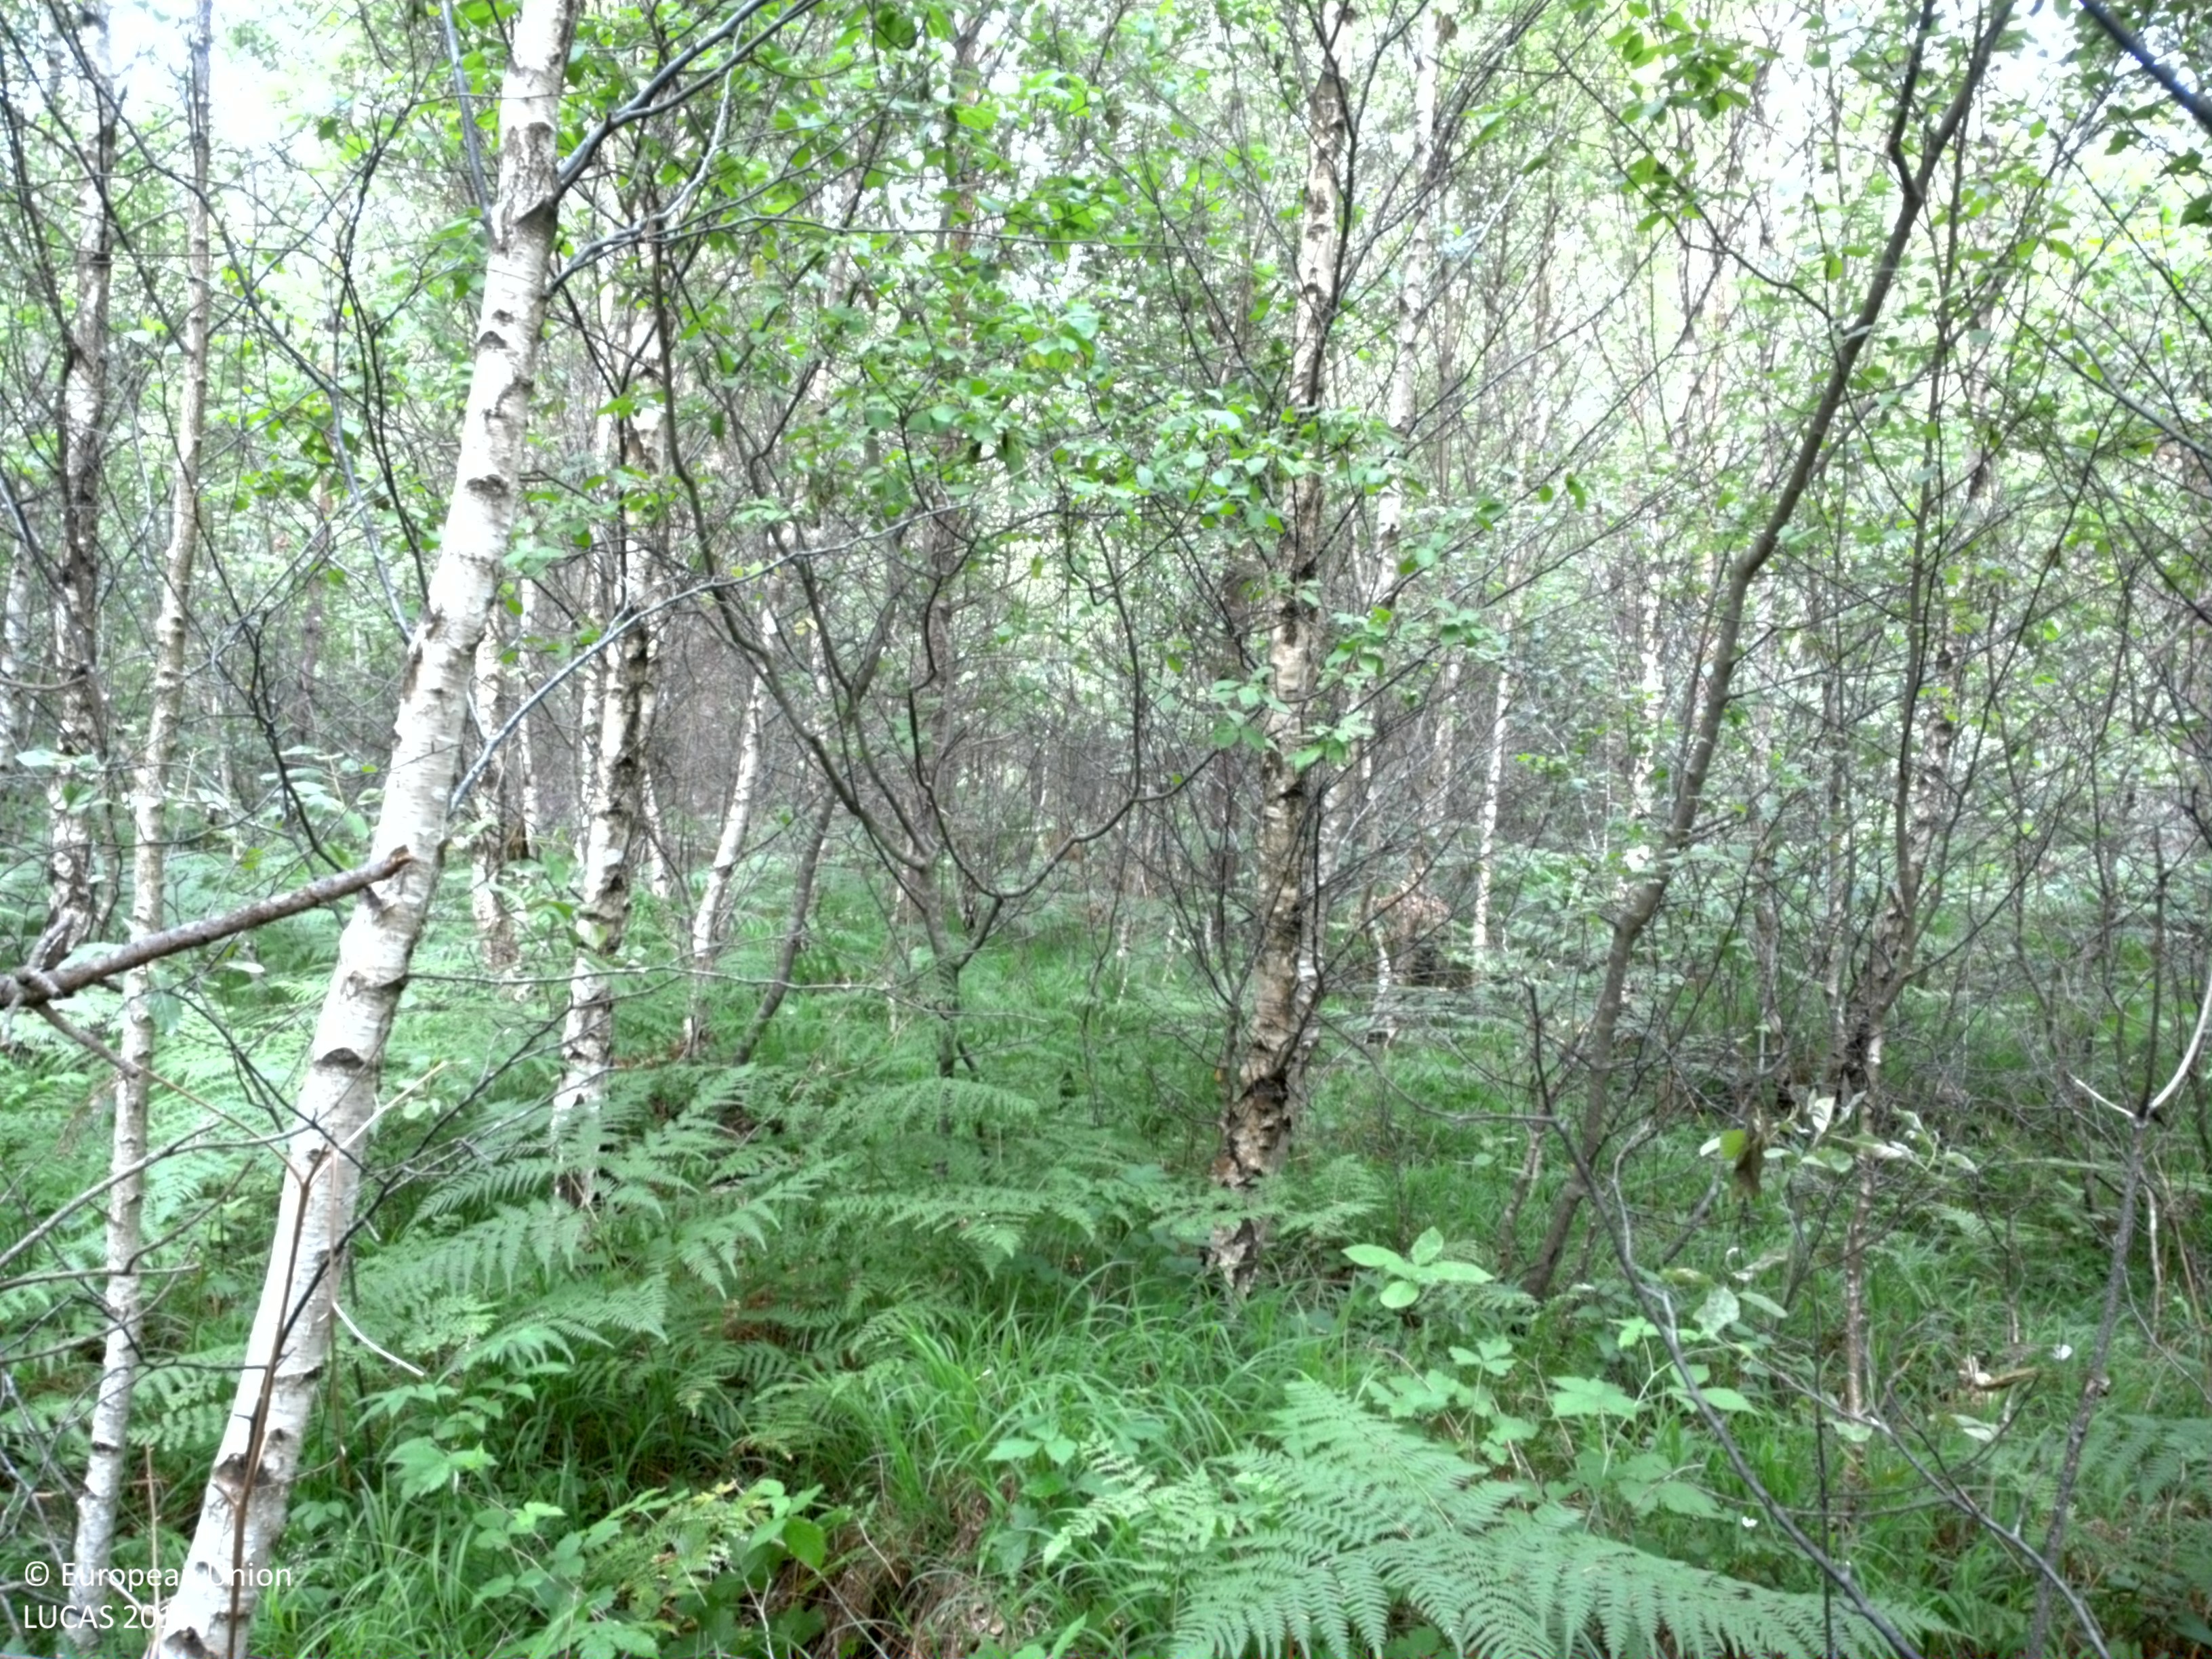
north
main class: Woodland
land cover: Pine dominated mixed woodland
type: hemiboreal forest and nemoral coniferous forest and mixed broadleaved-coniferous forest
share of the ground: > 75 %
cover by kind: coniferous forest trees 55 %, broadleaved forest trees 25 %, herbaceous plants 15 %, shrubs 5 %
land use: Forestry
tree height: > 5 m
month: July
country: SE
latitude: 57.2864
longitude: 18.1197
